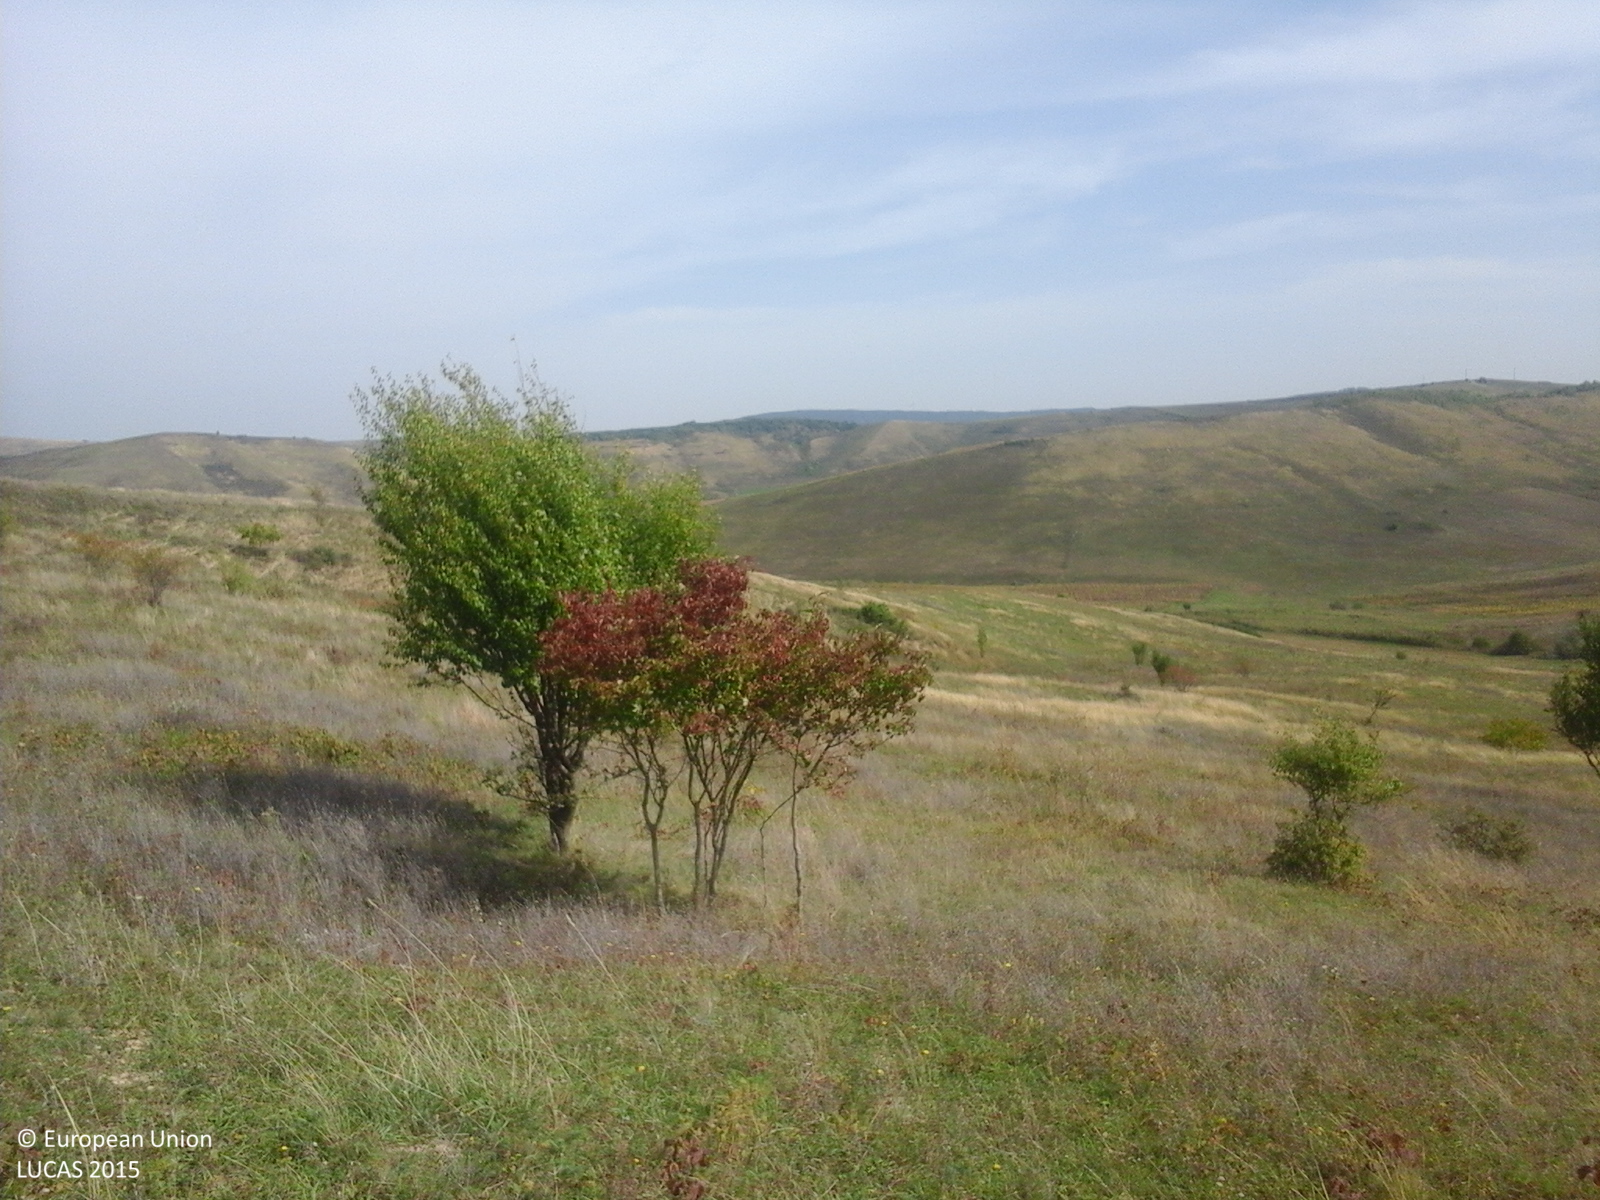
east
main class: Grassland
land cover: Grassland with sparse tree/shrub cover
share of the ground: > 75 %
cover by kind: herbaceous plants 95 %, broadleaved forest trees 5 %
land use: Agriculture (excluding fallow land and kitchen gardens)
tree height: < 5 m
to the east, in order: Grassland with sparse tree/shrub cover; Spontaneously vegetated surfaces; Grassland with sparse tree/shrub cover
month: September
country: RO
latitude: 46.7406
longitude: 23.8575
